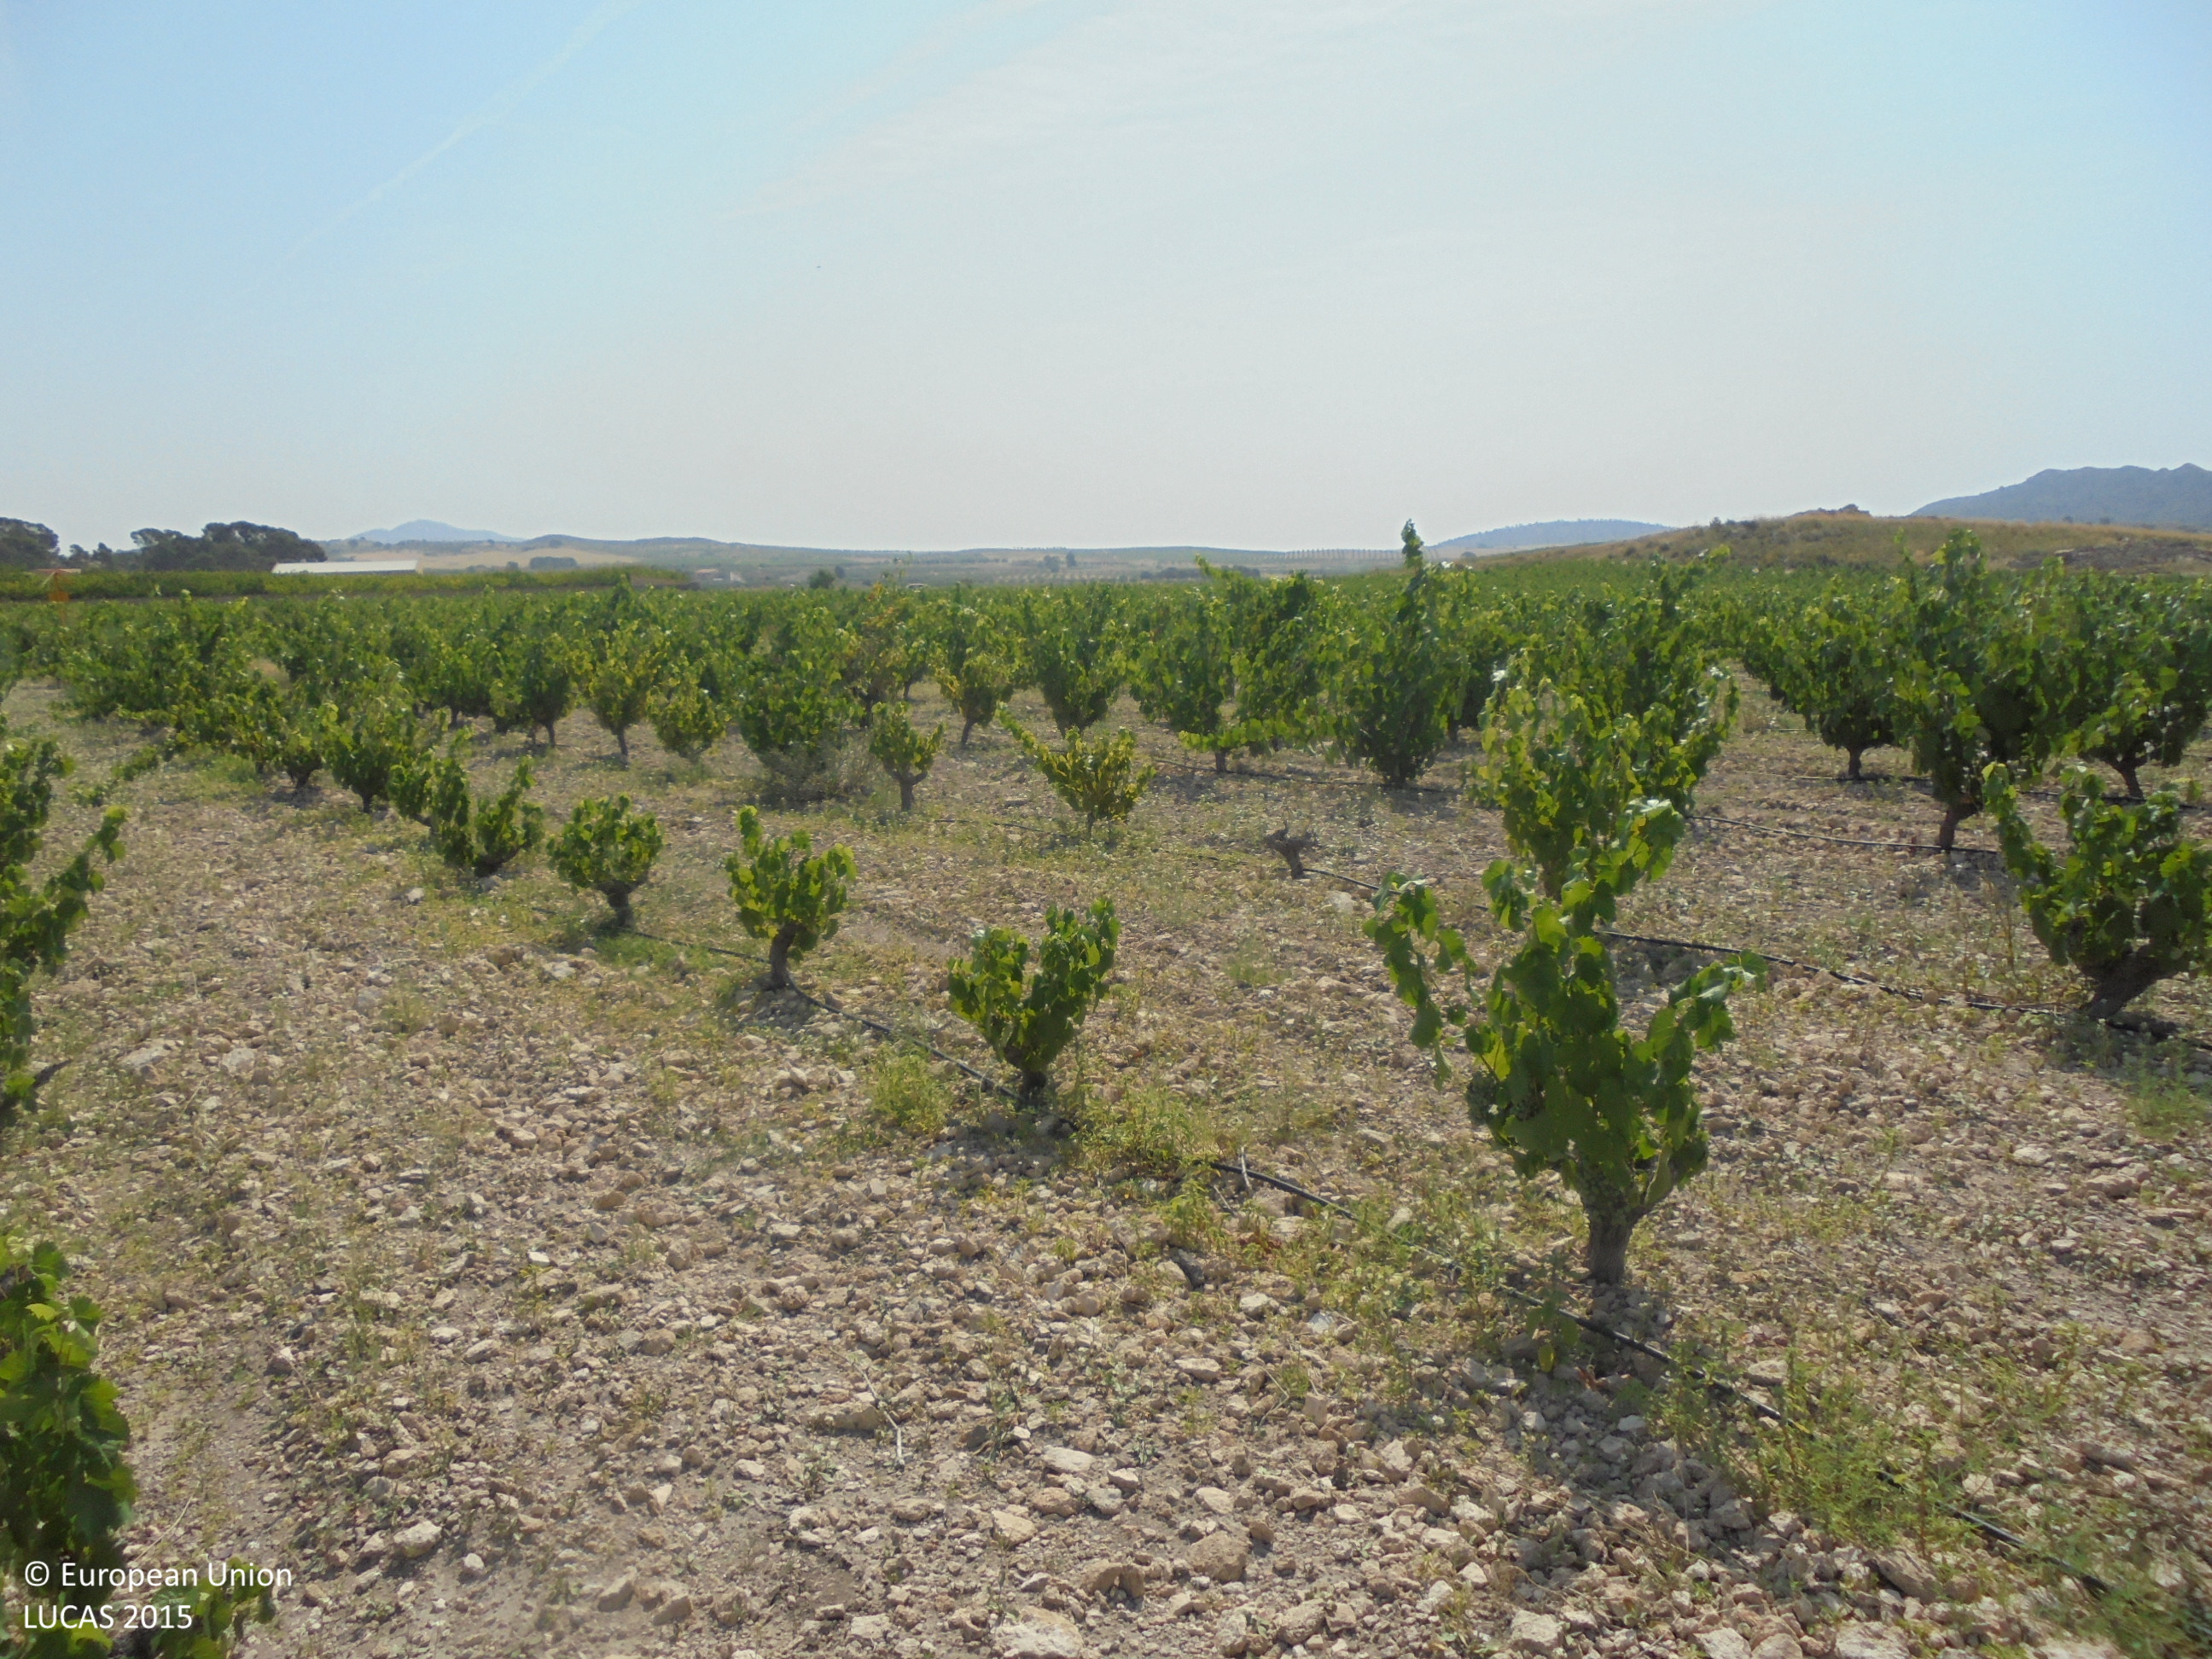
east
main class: Cropland
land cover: Vineyards
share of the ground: 25 - 50 %
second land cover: Spontaneously vegetated surfaces
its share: 25 - 50 %
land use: Agriculture (excluding fallow land and kitchen gardens)
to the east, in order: Vineyards; Spontaneously vegetated surfaces; Tracks; Grass margins; Barley; Spontaneously vegetated surfaces
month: July
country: ES
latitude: 38.6024
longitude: -1.6491
